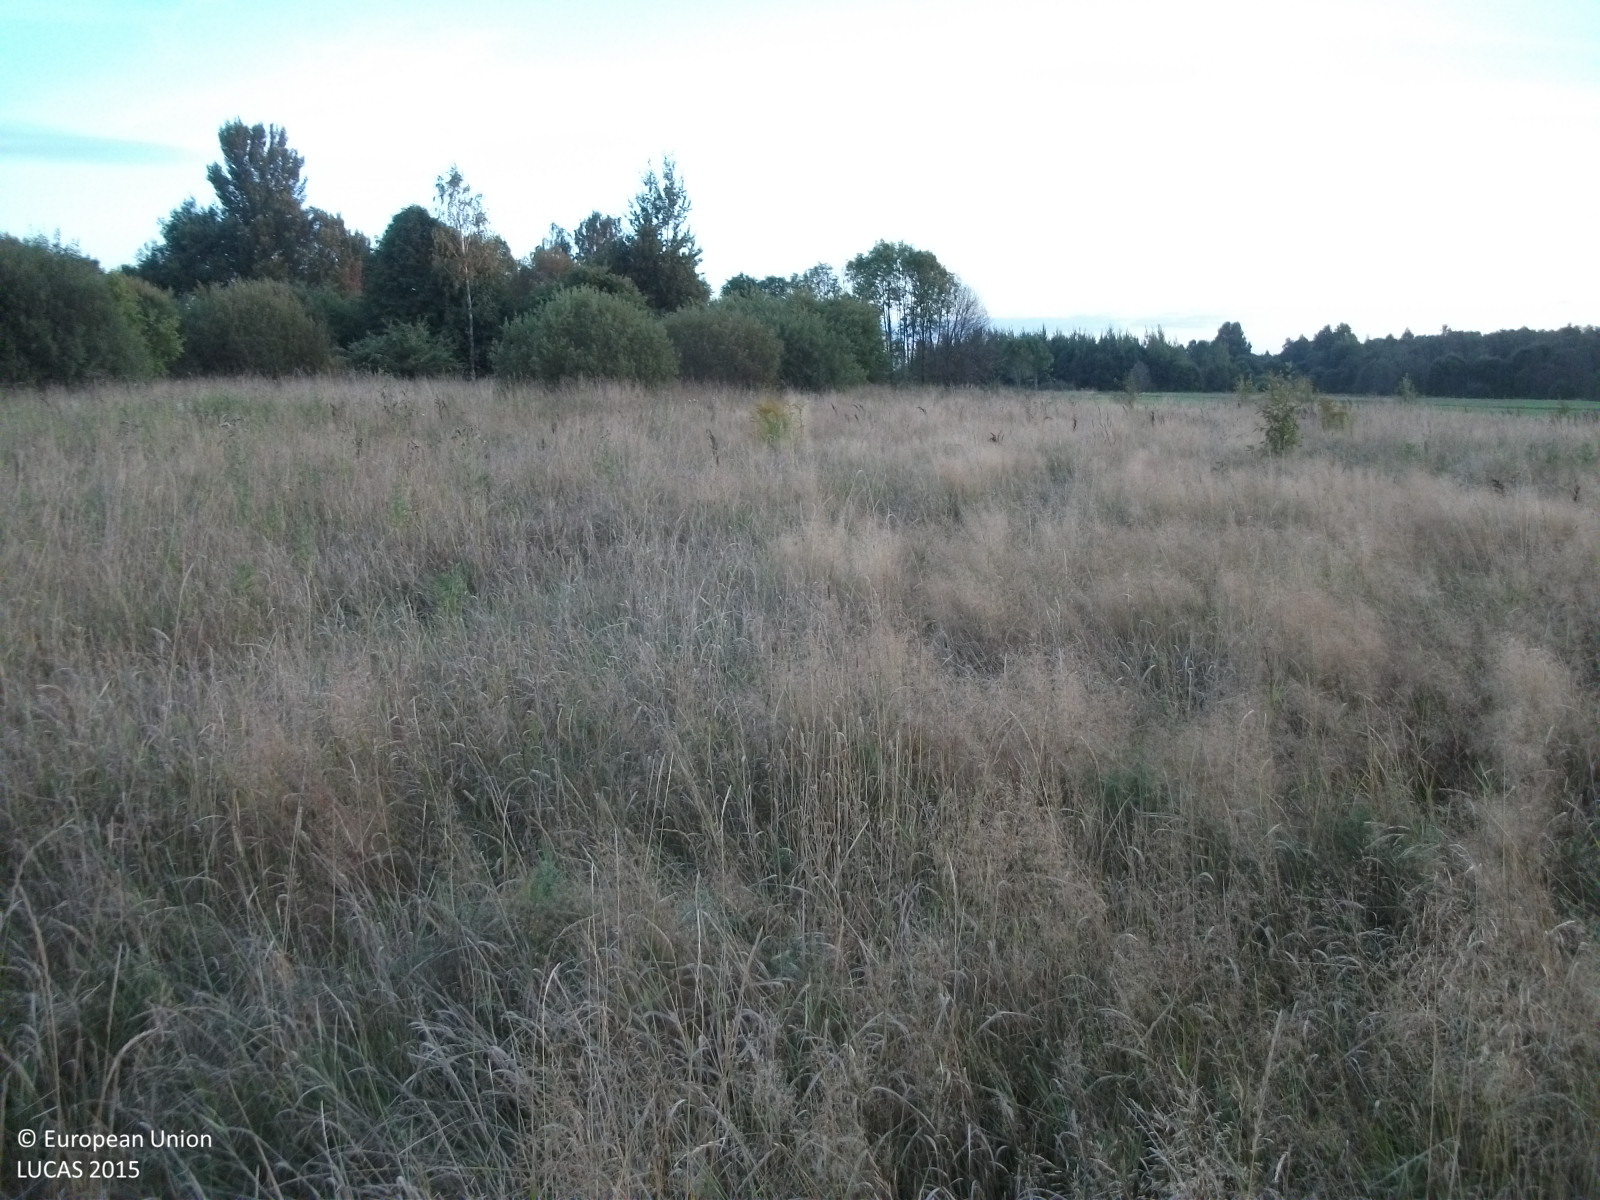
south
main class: Grassland
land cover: Grassland with sparse tree/shrub cover
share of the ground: > 75 %
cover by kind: herbaceous plants 90 %, broadleaved forest trees 5 %, shrubs 5 %
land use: Semi-natural and natural areas not in use
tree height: < 5 m
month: September
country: LV
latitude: 57.5641
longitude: 24.5859
